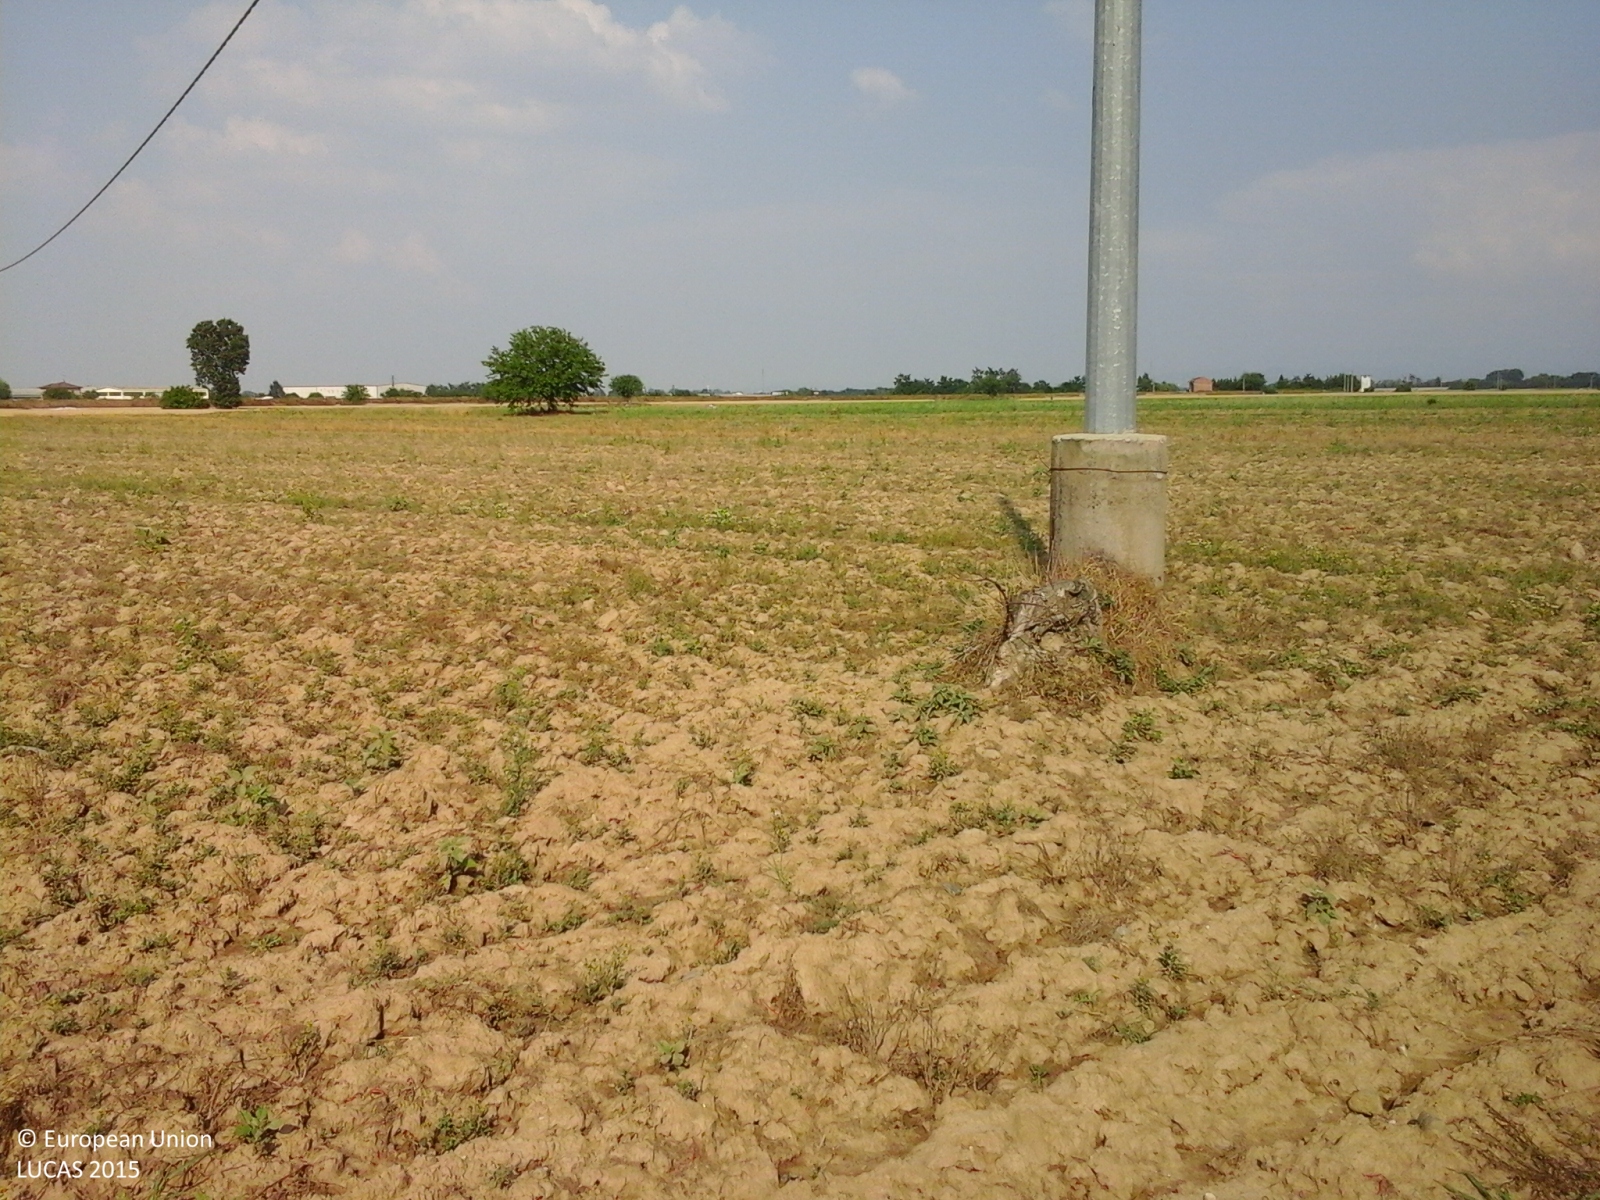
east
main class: Grassland
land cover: Spontaneously vegetated surfaces
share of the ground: > 75 %
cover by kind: herbaceous plants 100 %
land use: Agriculture (excluding fallow land and kitchen gardens)
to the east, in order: Spontaneously vegetated surfaces; Electric lines; Spontaneously vegetated surfaces; Other bare soil; Tracks; Other bare soil; Other fresh vegetables
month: June
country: IT
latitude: 44.8277
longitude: 8.5736
